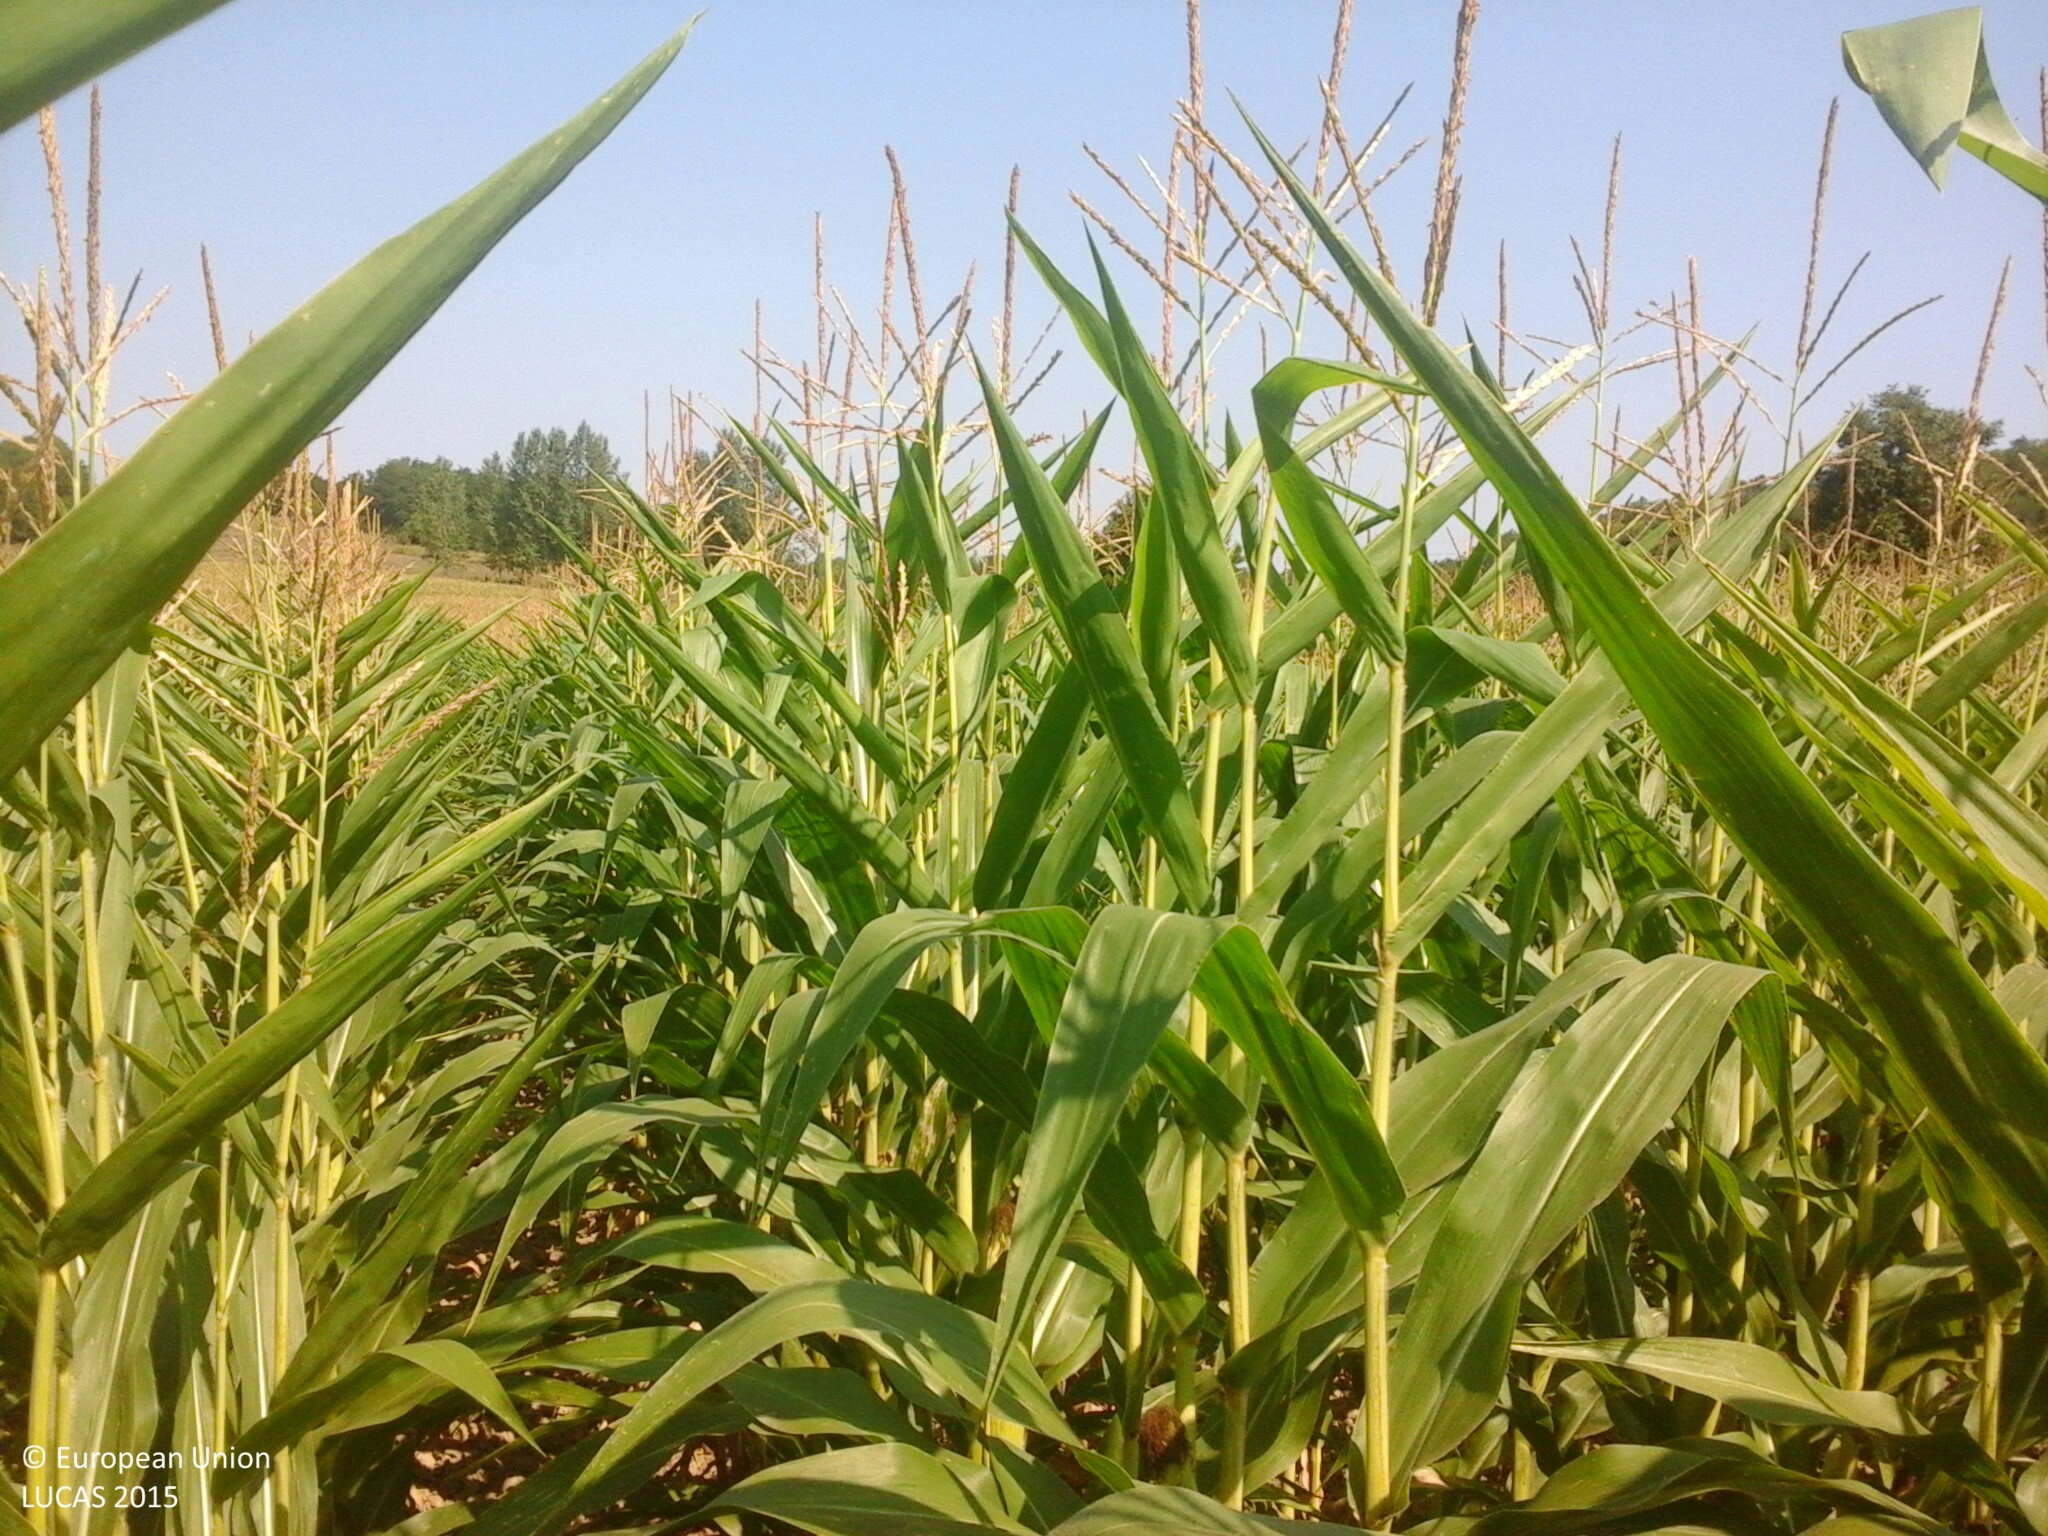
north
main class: Cropland
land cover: Maize
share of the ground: > 75 %
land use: Agriculture (excluding fallow land and kitchen gardens)
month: August
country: HU
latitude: 47.3644
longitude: 18.1013
